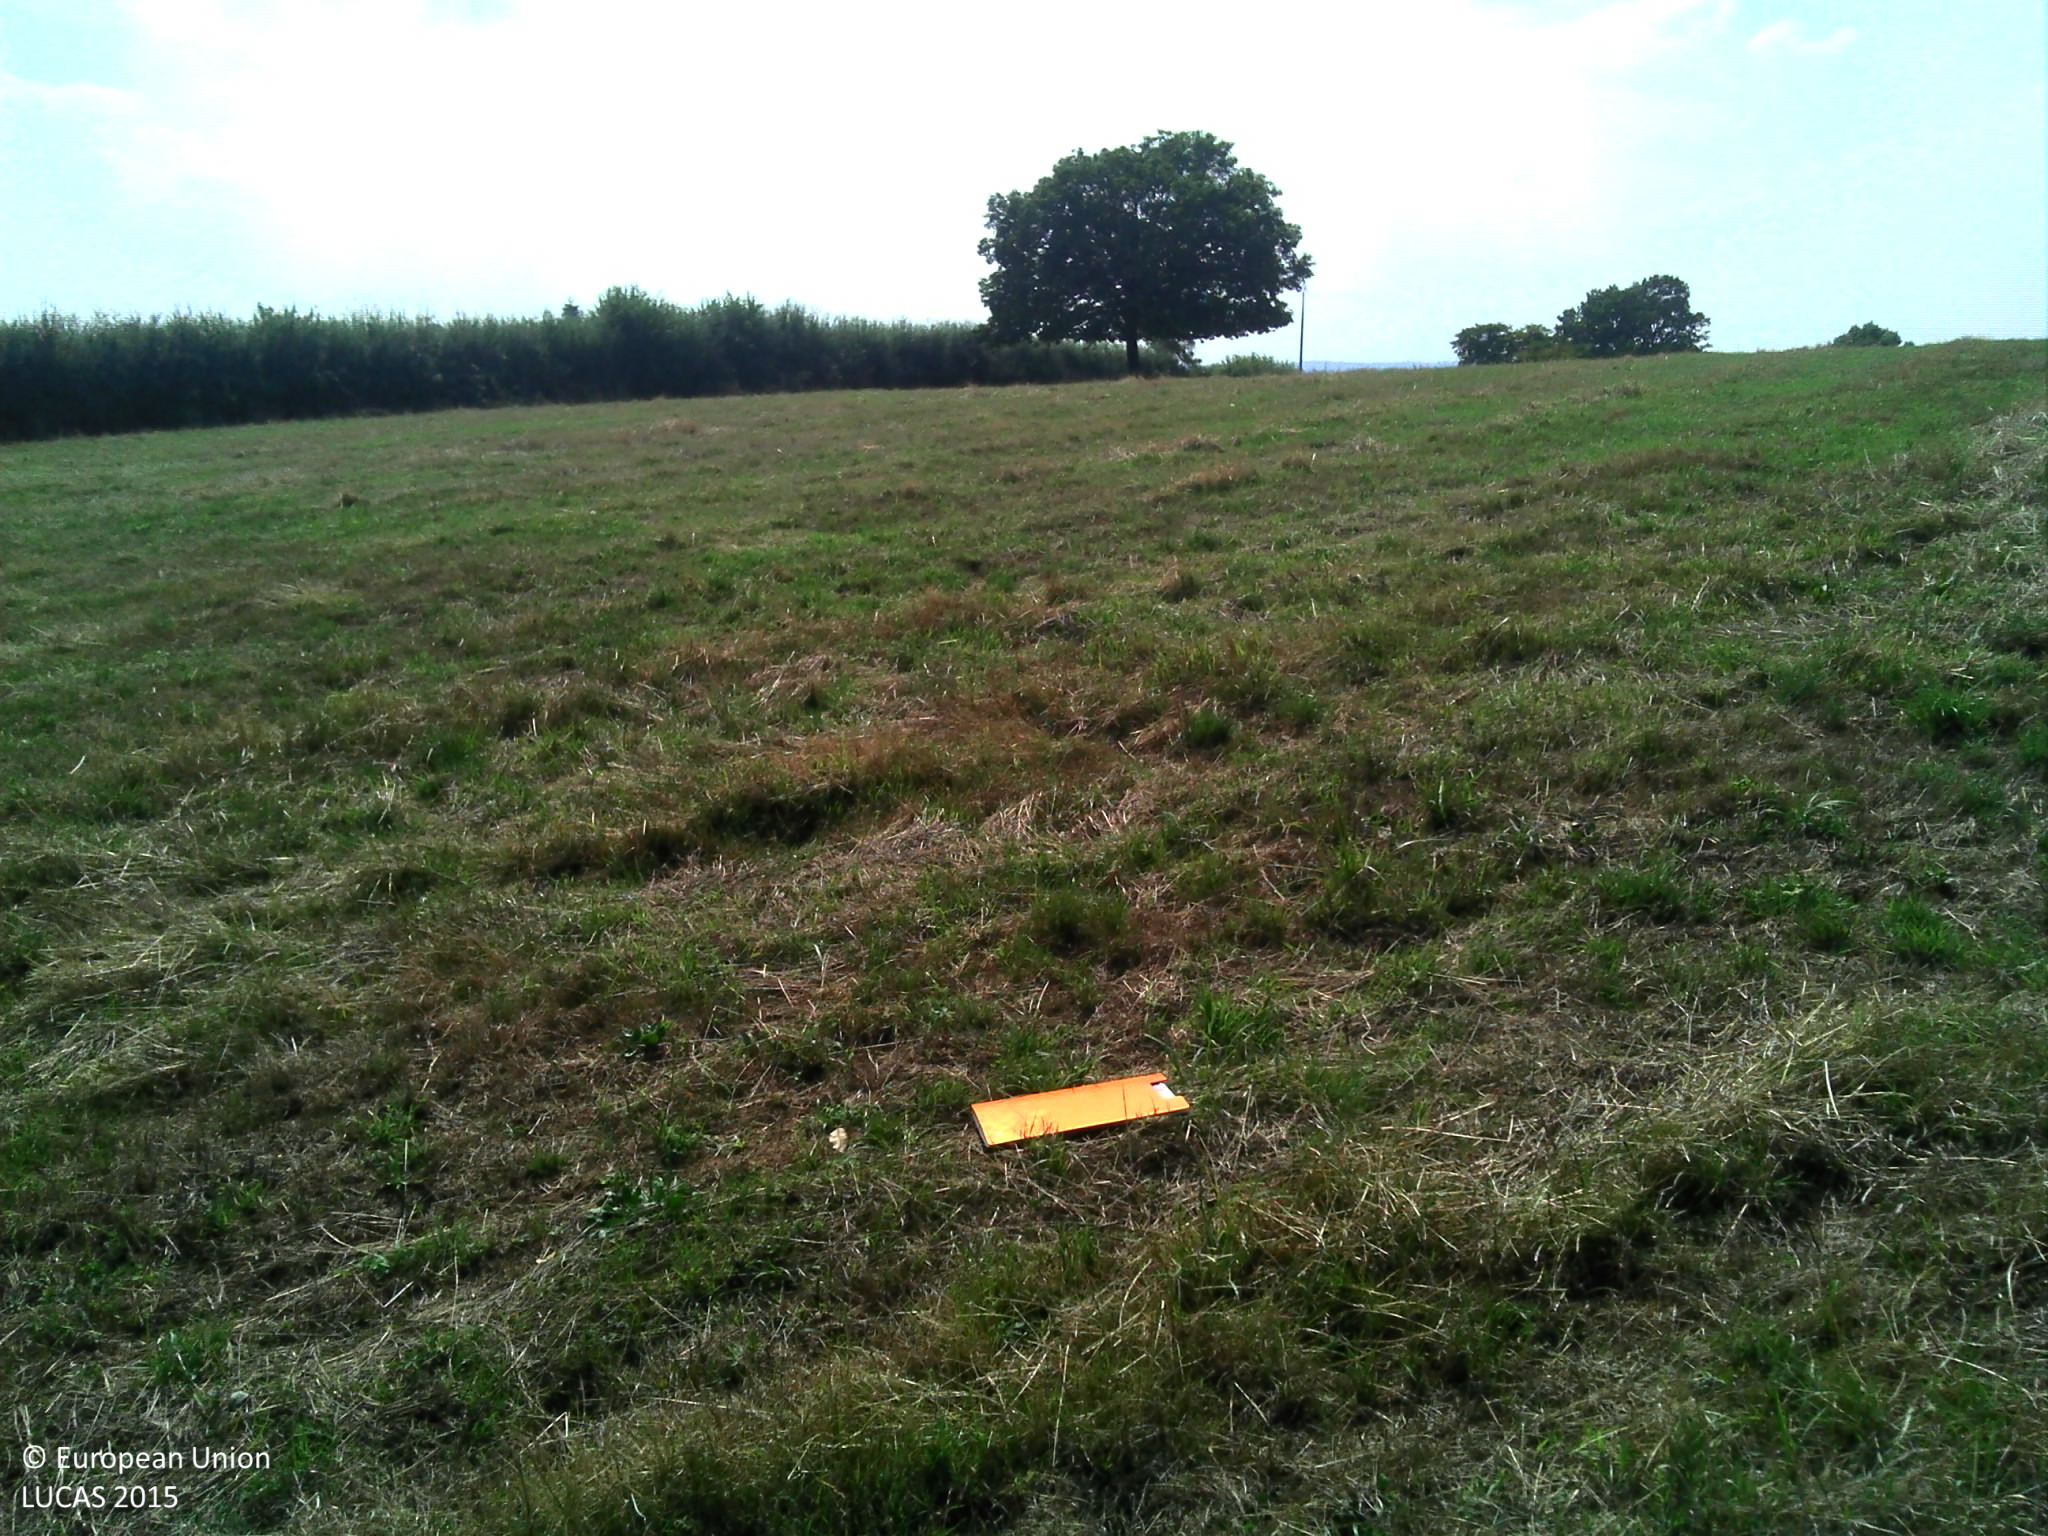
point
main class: Grassland
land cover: Grassland without tree/shrub cover
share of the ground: > 75 %
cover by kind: herbaceous plants 100 %
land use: Agriculture (excluding fallow land and kitchen gardens)
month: August
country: FR
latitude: 46.3803
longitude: 3.6678
